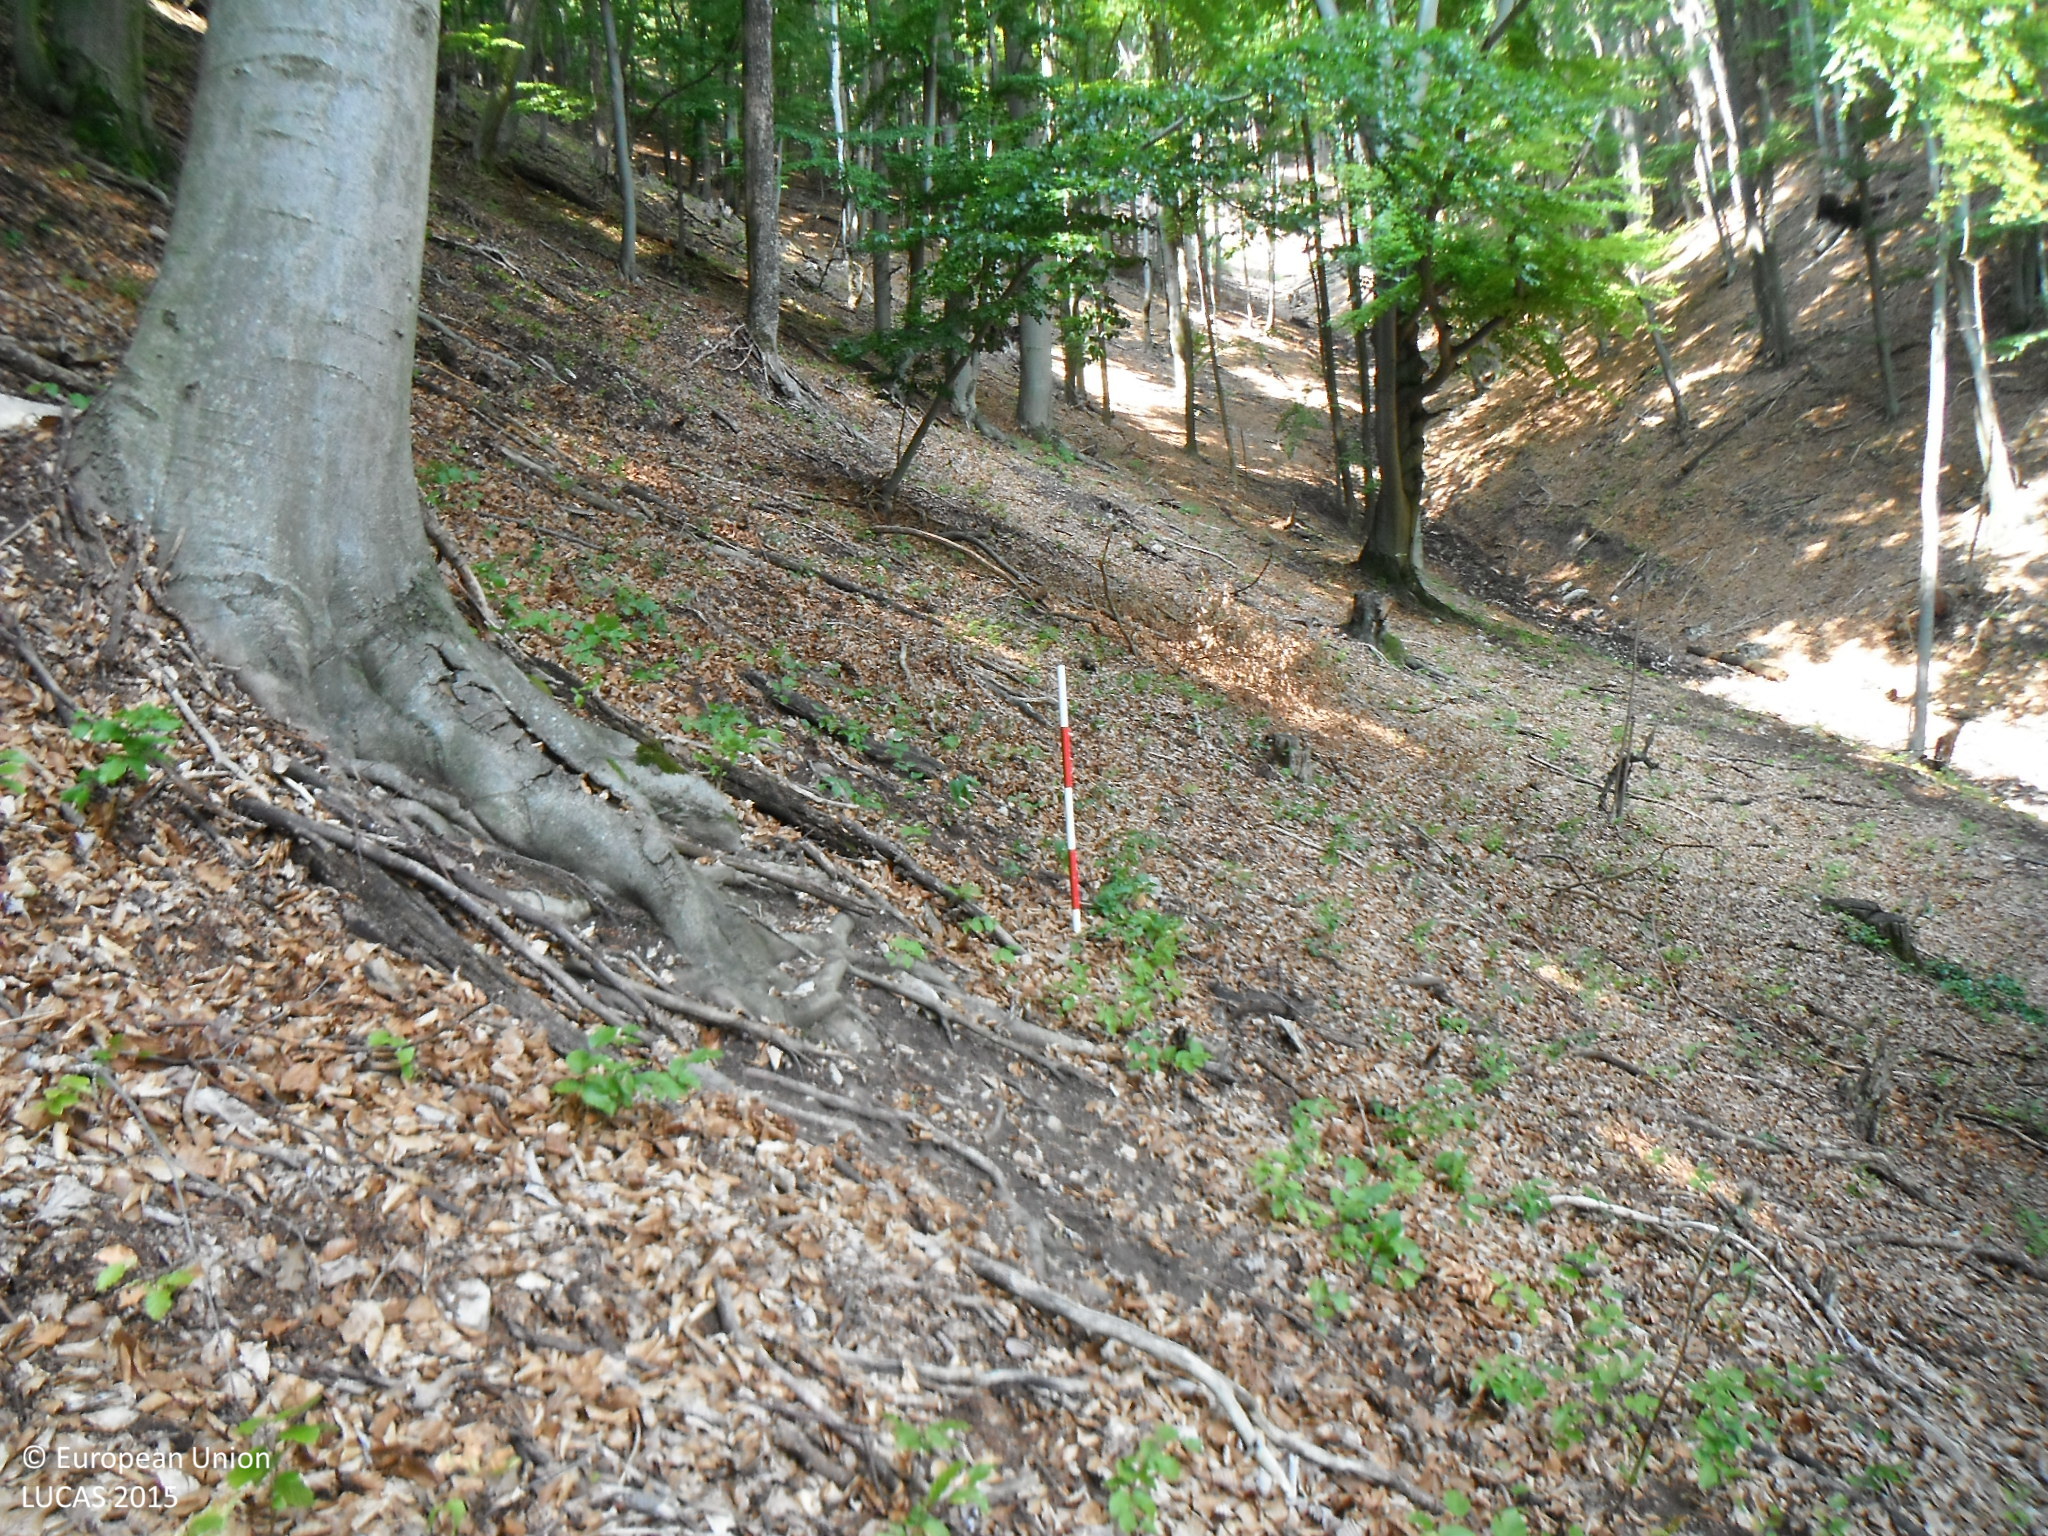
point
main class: Woodland
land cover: Broadleaved woodland
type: mountainous beech forest
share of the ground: > 75 %
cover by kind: broadleaved forest trees 60 %, unconsolidated bare surface 30 %, herbaceous plants 10 %
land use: Forestry
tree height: > 5 m
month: August
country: SK
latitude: 48.9725
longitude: 18.3638
